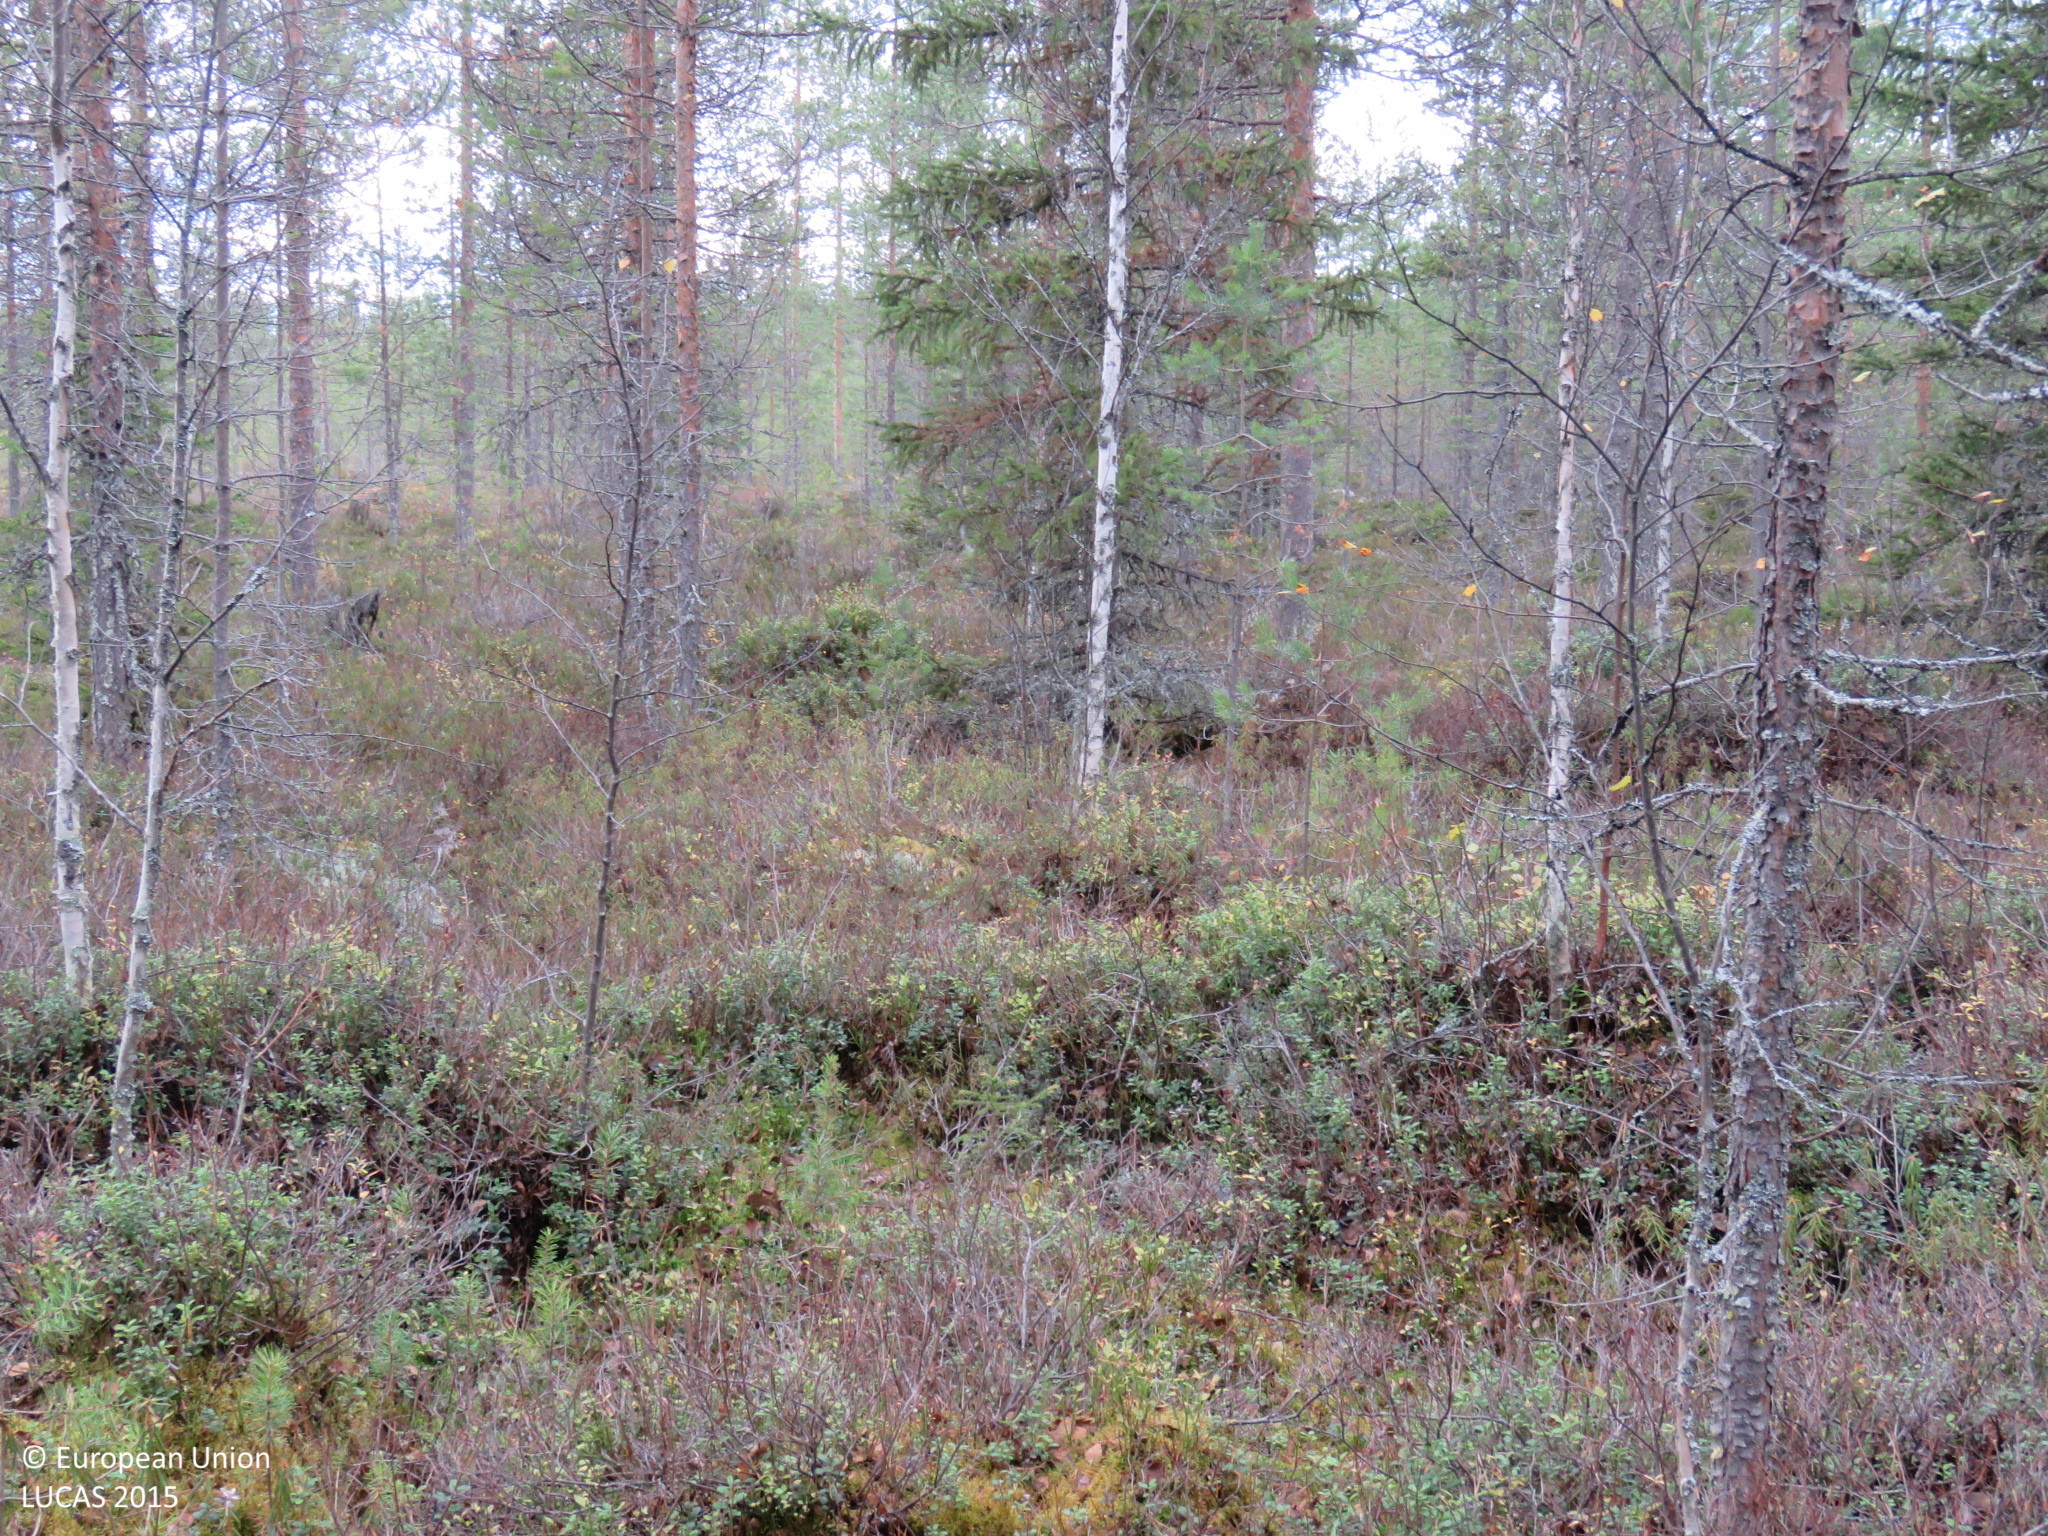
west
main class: Woodland
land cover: Pine dominated coniferous woodland
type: boreal forest
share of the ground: > 75 %
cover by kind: coniferous forest trees 60 %, shrubs 20 %, broadleaved forest trees 15 %, lichens and mosses 5 %
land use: Forestry
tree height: > 5 m
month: October
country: FI
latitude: 64.5652
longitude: 27.0101
